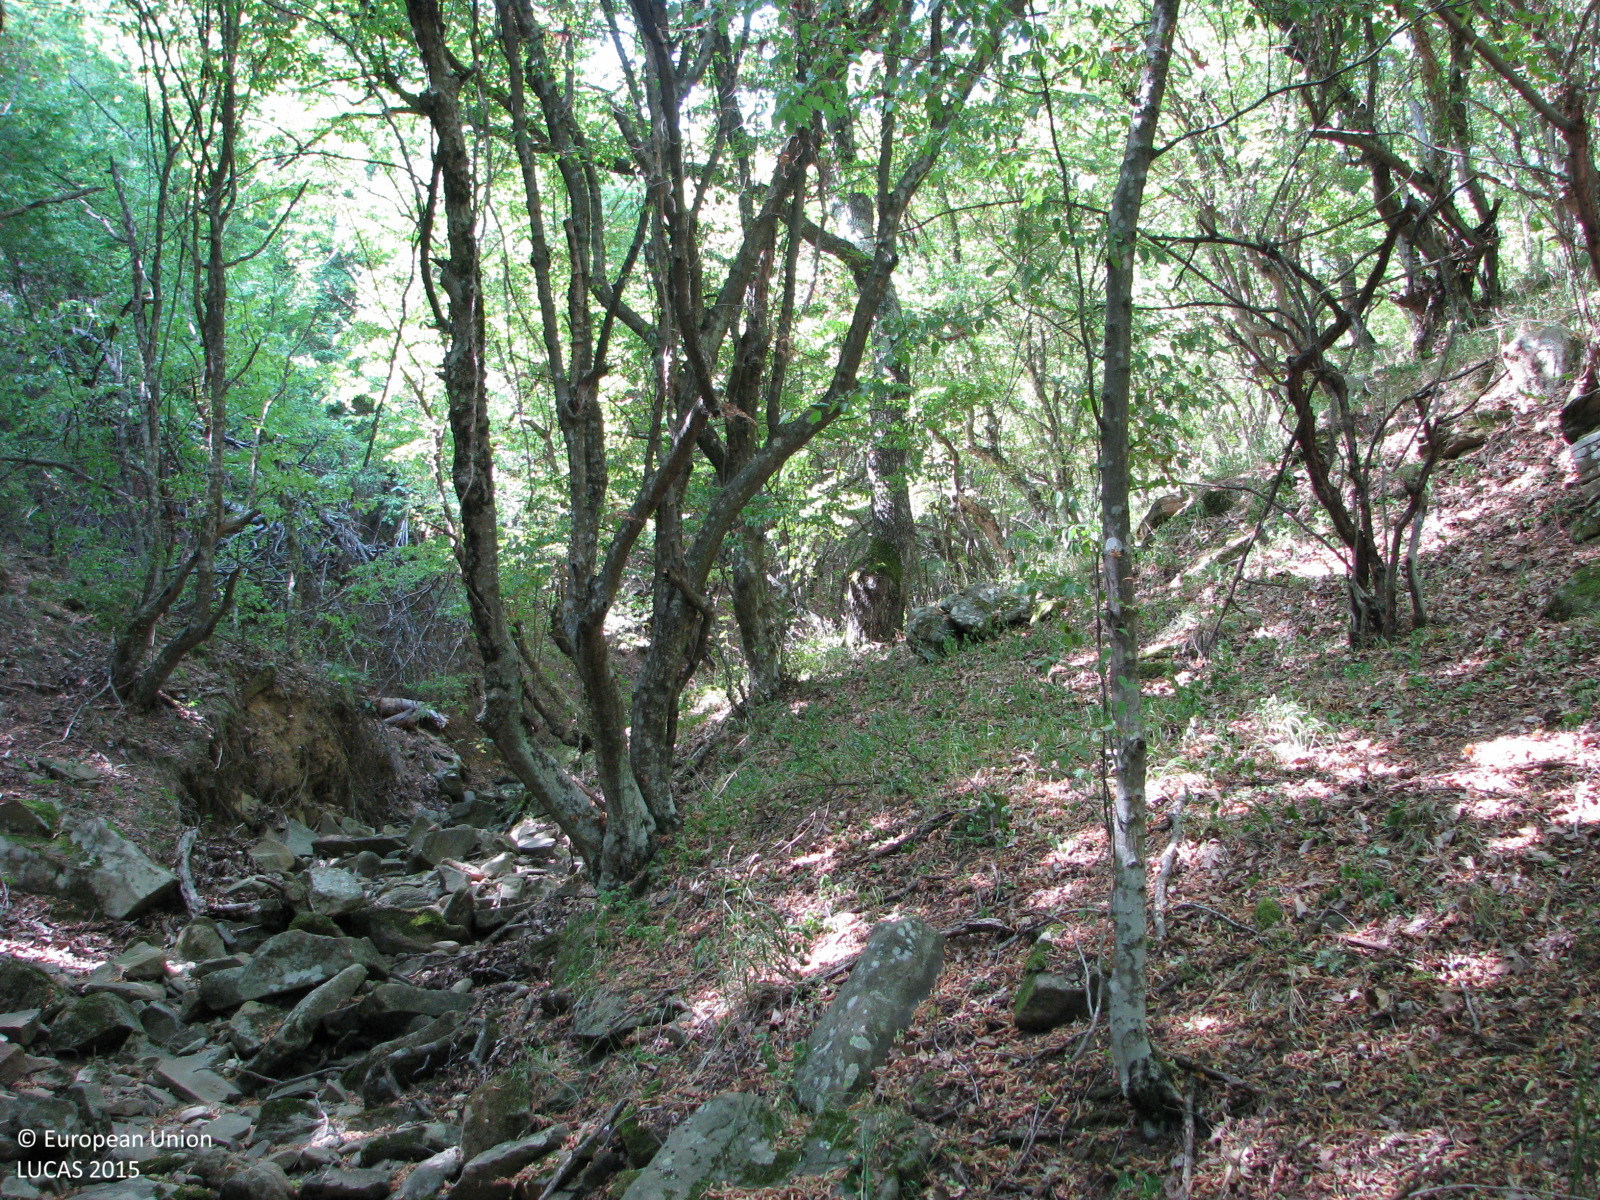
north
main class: Woodland
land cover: Broadleaved woodland
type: beech forest
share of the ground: 50 - 75 %
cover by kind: broadleaved forest trees 65 %, unconsolidated bare surface 25 %, herbaceous plants 10 %
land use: Forestry
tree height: > 5 m
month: August
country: BG
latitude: 42.7540
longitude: 26.6548
